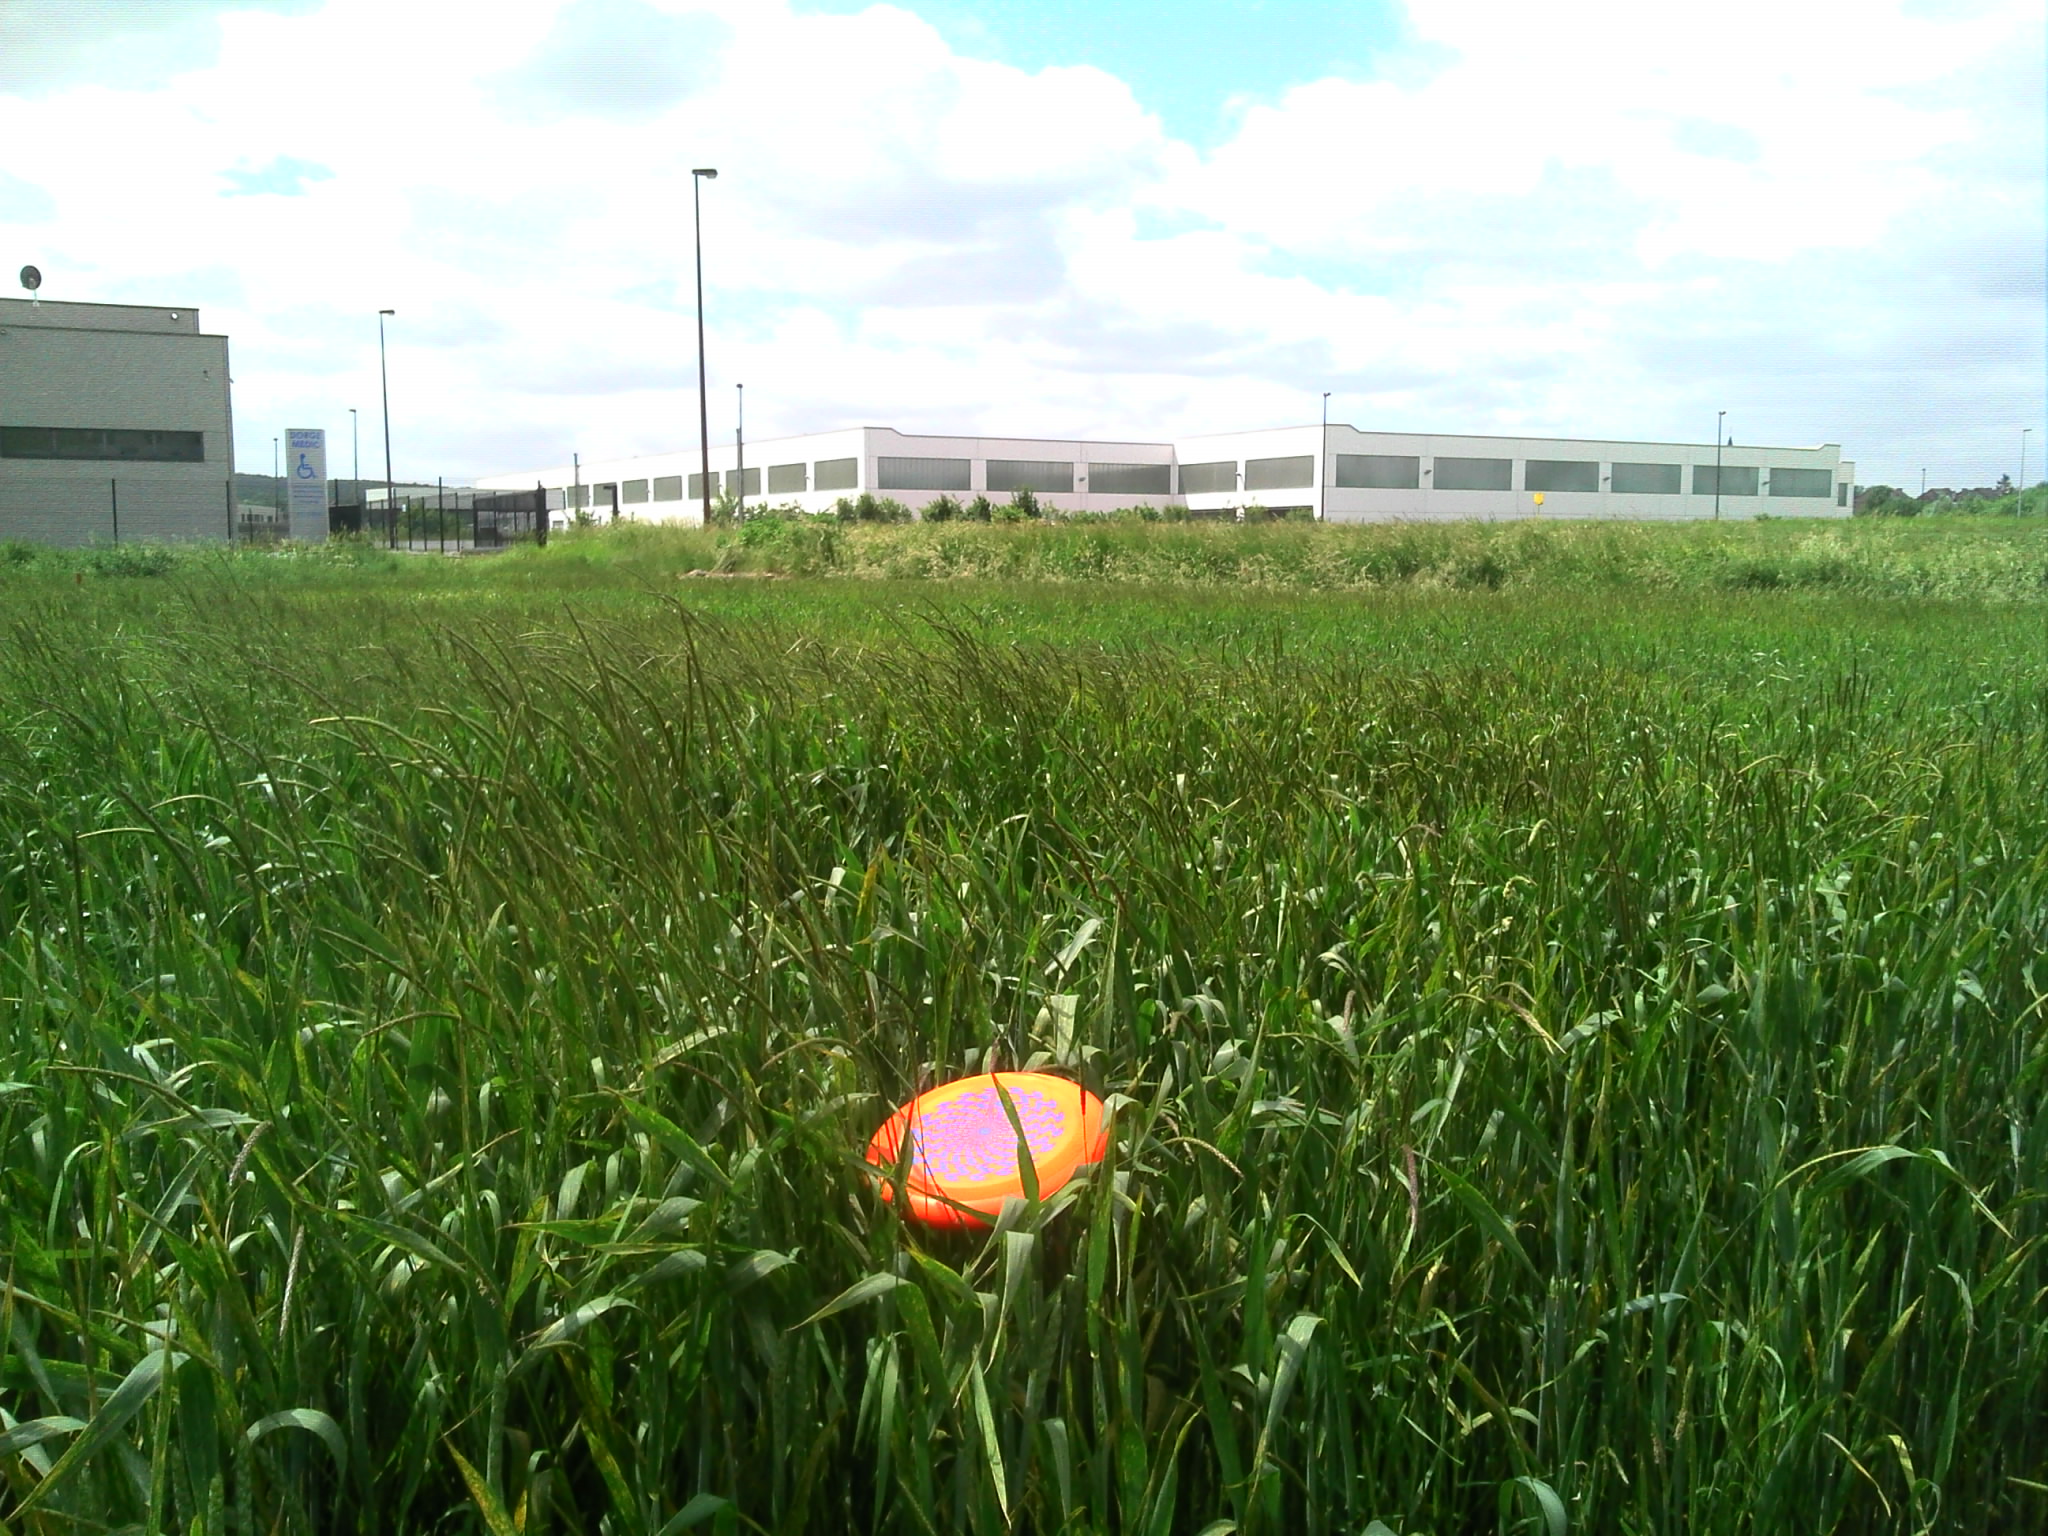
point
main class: Cropland
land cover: Common wheat
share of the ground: > 75 %
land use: Agriculture (excluding fallow land and kitchen gardens)
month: June
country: BE
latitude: 50.4581
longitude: 4.7143
